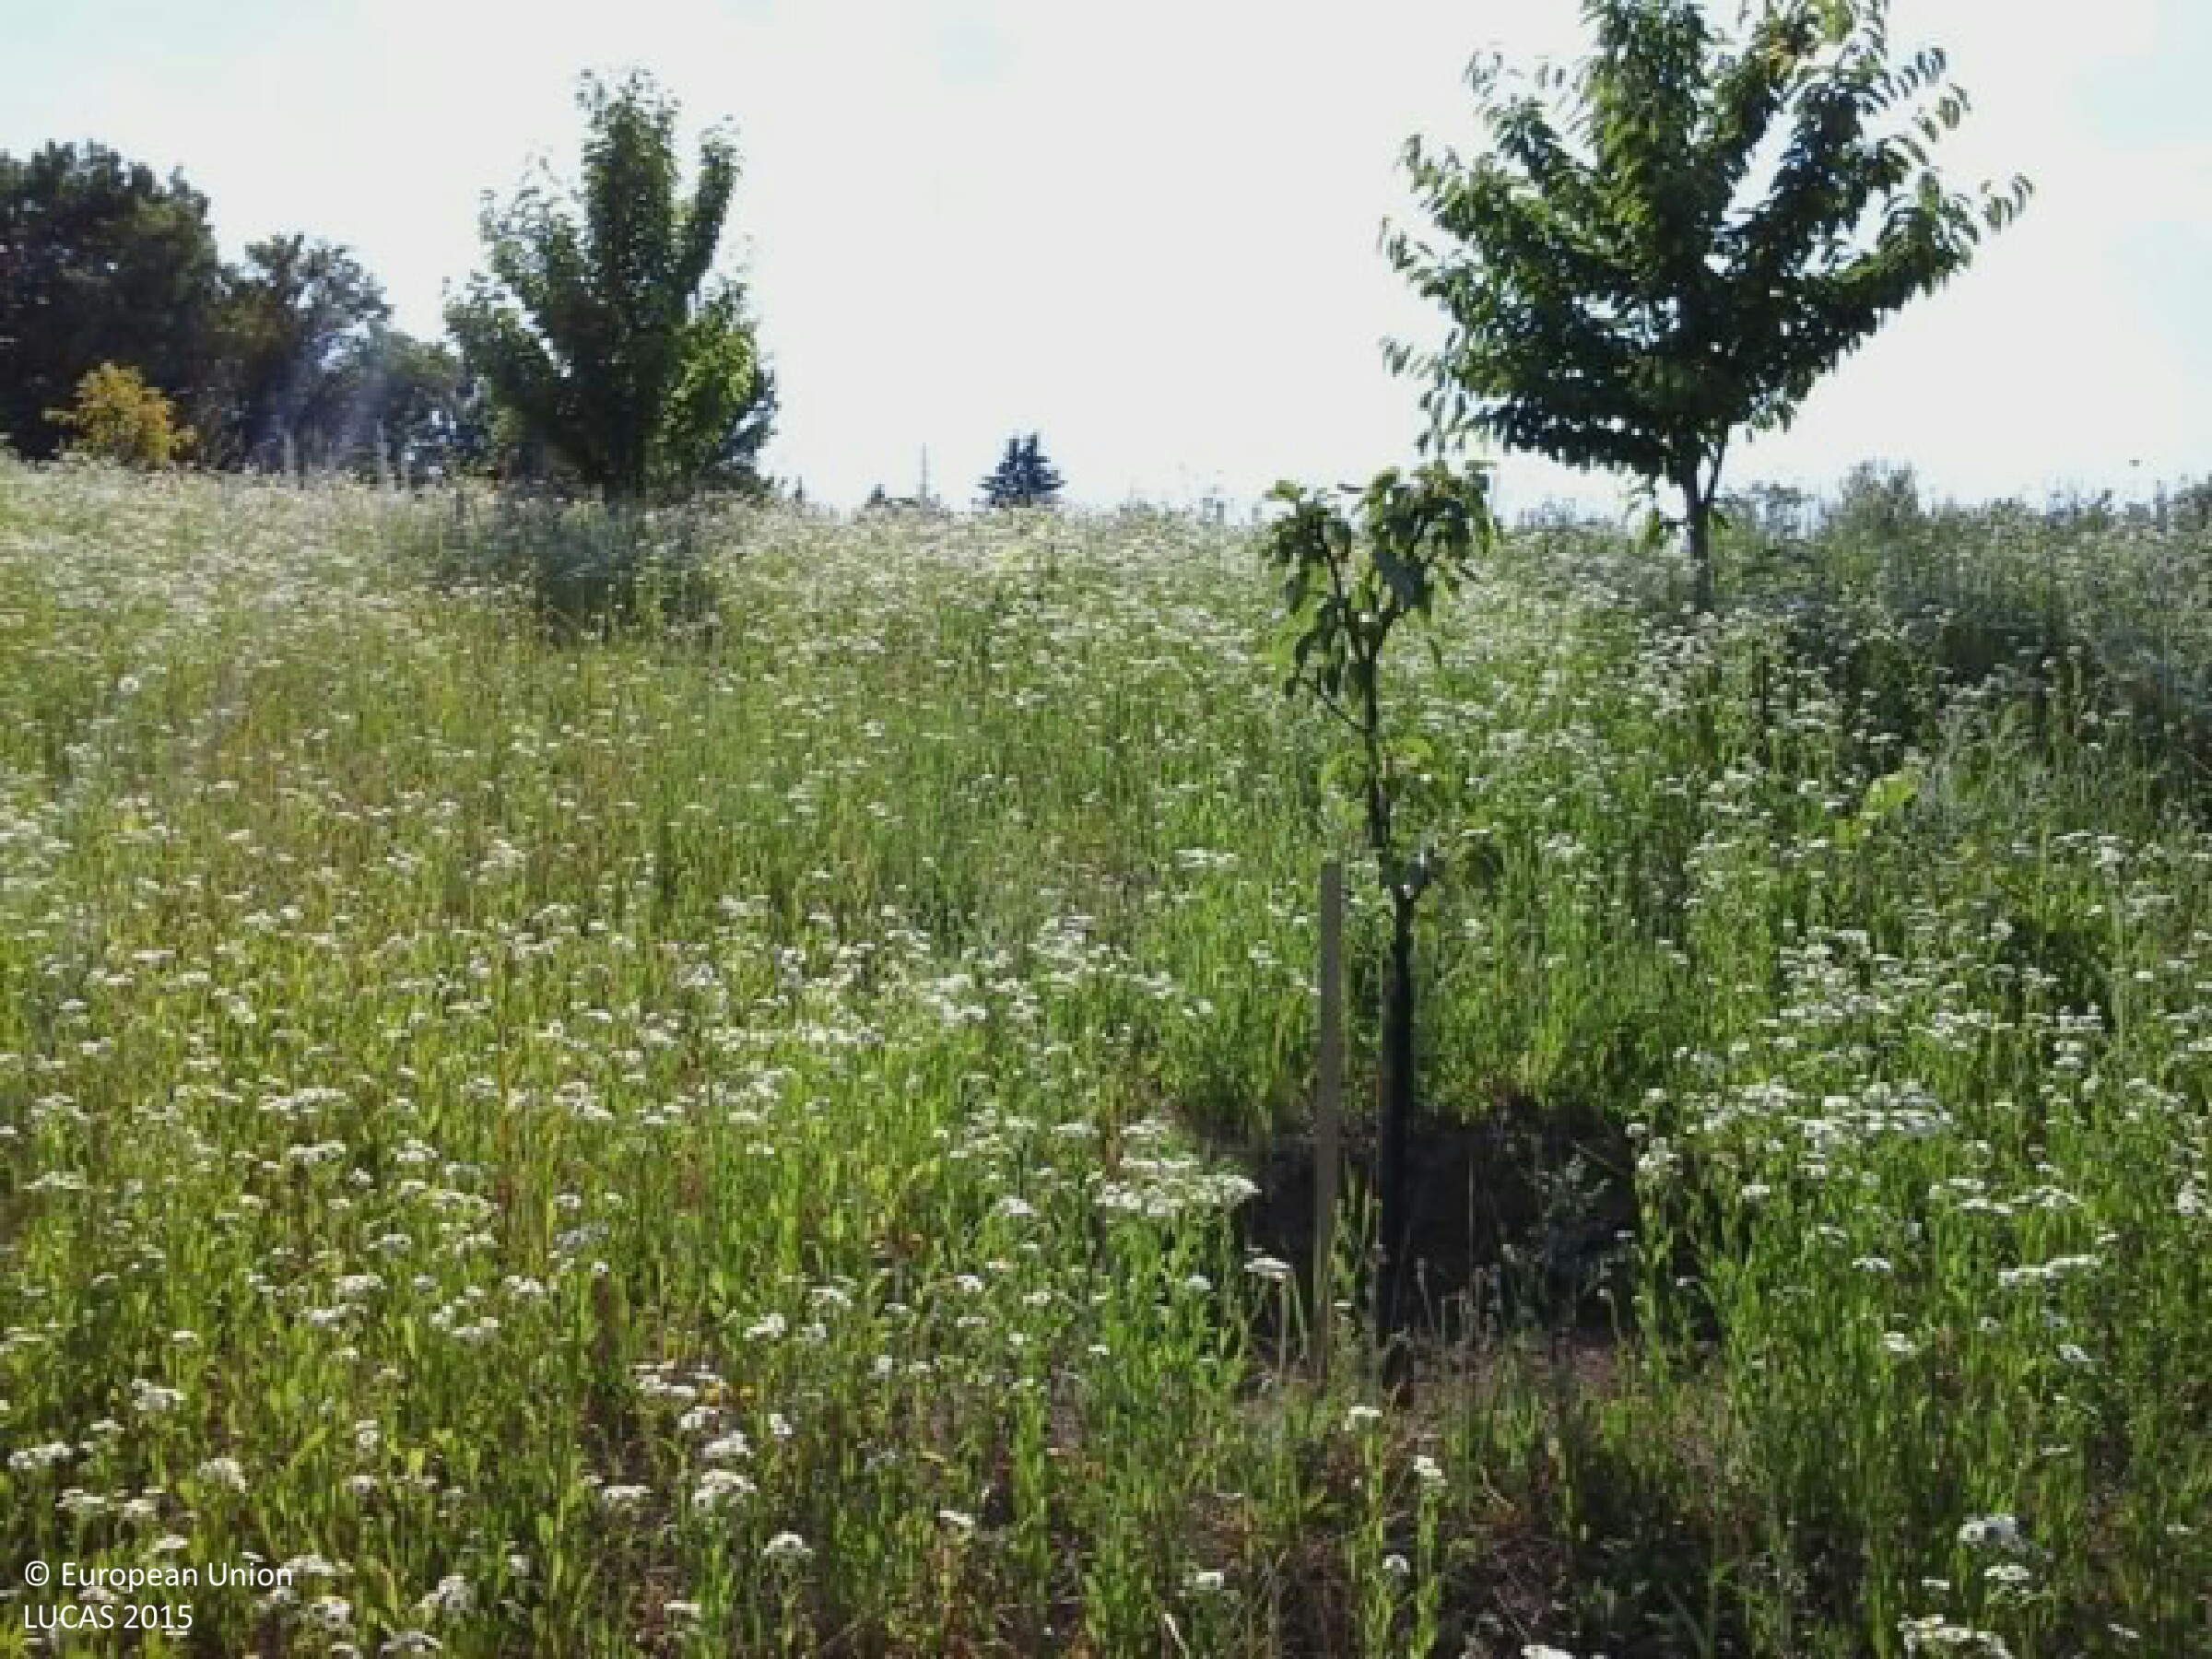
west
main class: Grassland
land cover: Grassland with sparse tree/shrub cover
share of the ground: > 75 %
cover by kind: herbaceous plants 95 %, broadleaved forest trees 5 %
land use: Agriculture (excluding fallow land and kitchen gardens)
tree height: < 5 m
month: July
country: HU
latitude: 47.7869
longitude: 19.1630
